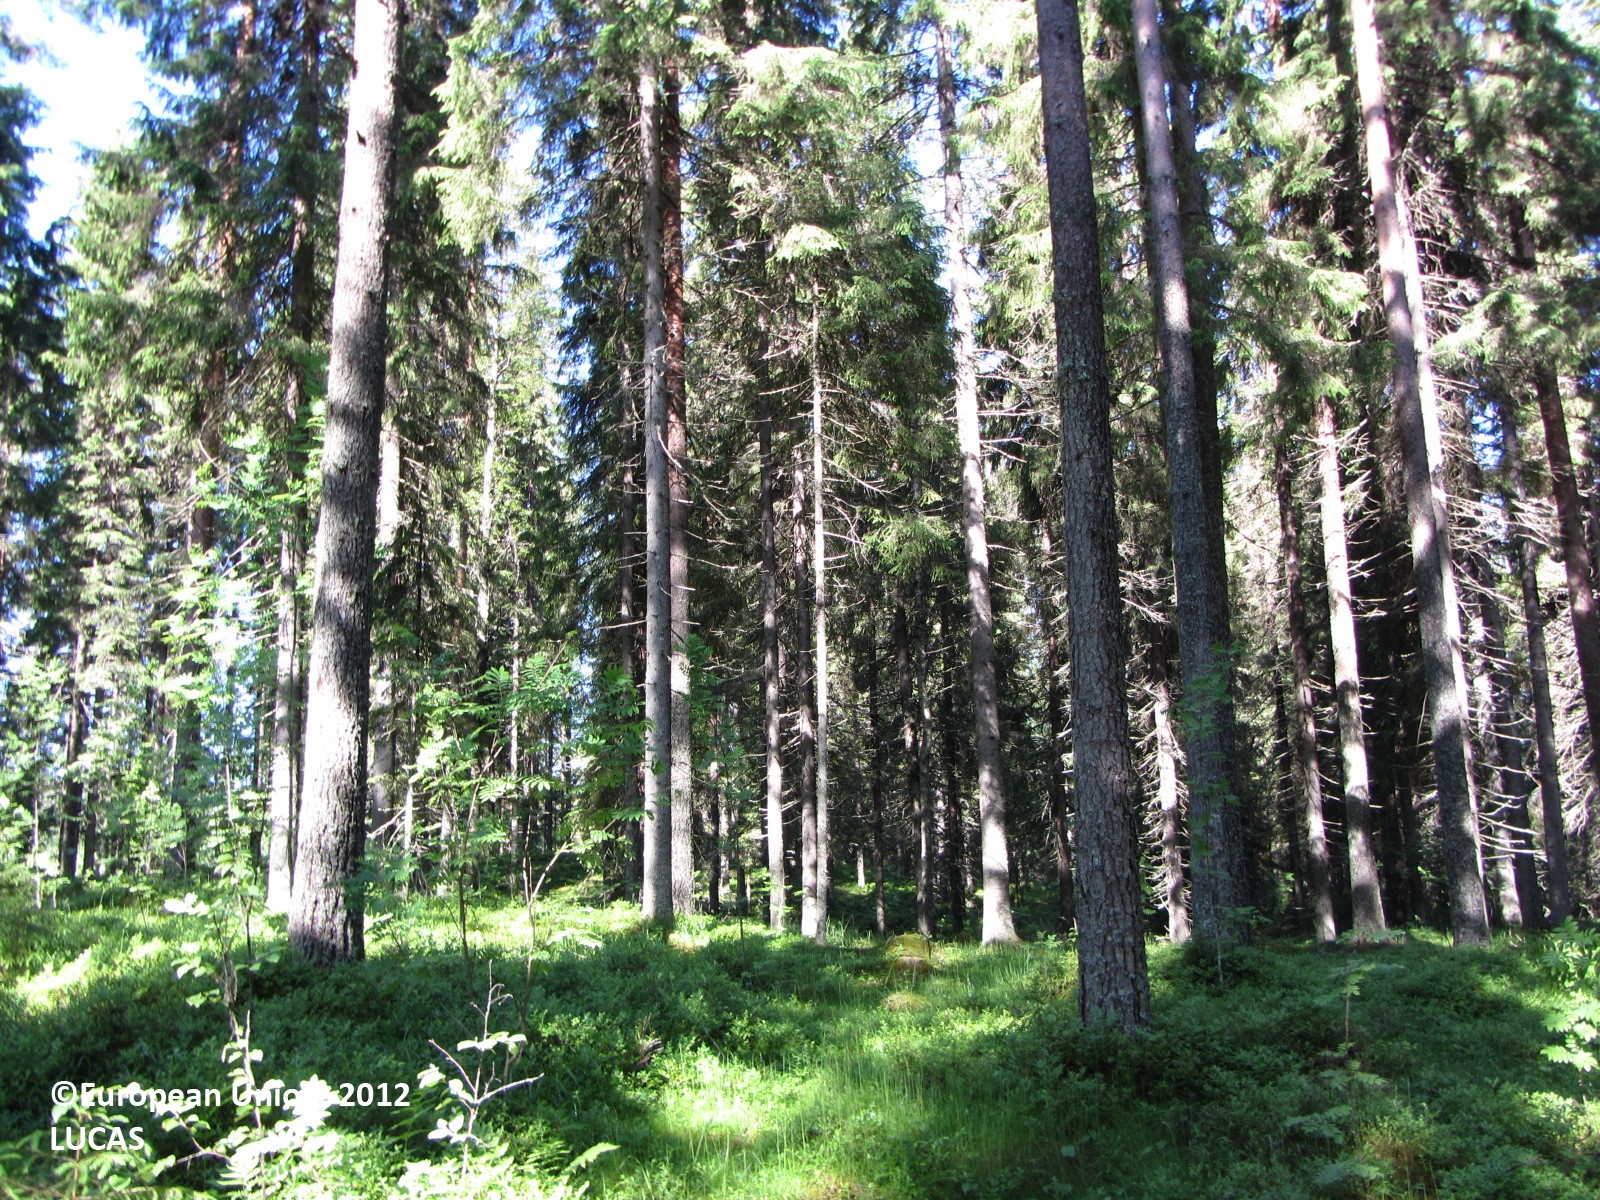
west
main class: Woodland
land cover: Spruce dominated coniferous woodland
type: boreal forest
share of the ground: > 75 %
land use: Forestry
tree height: > 5 m
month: June
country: FI
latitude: 62.1737
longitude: 25.2999
